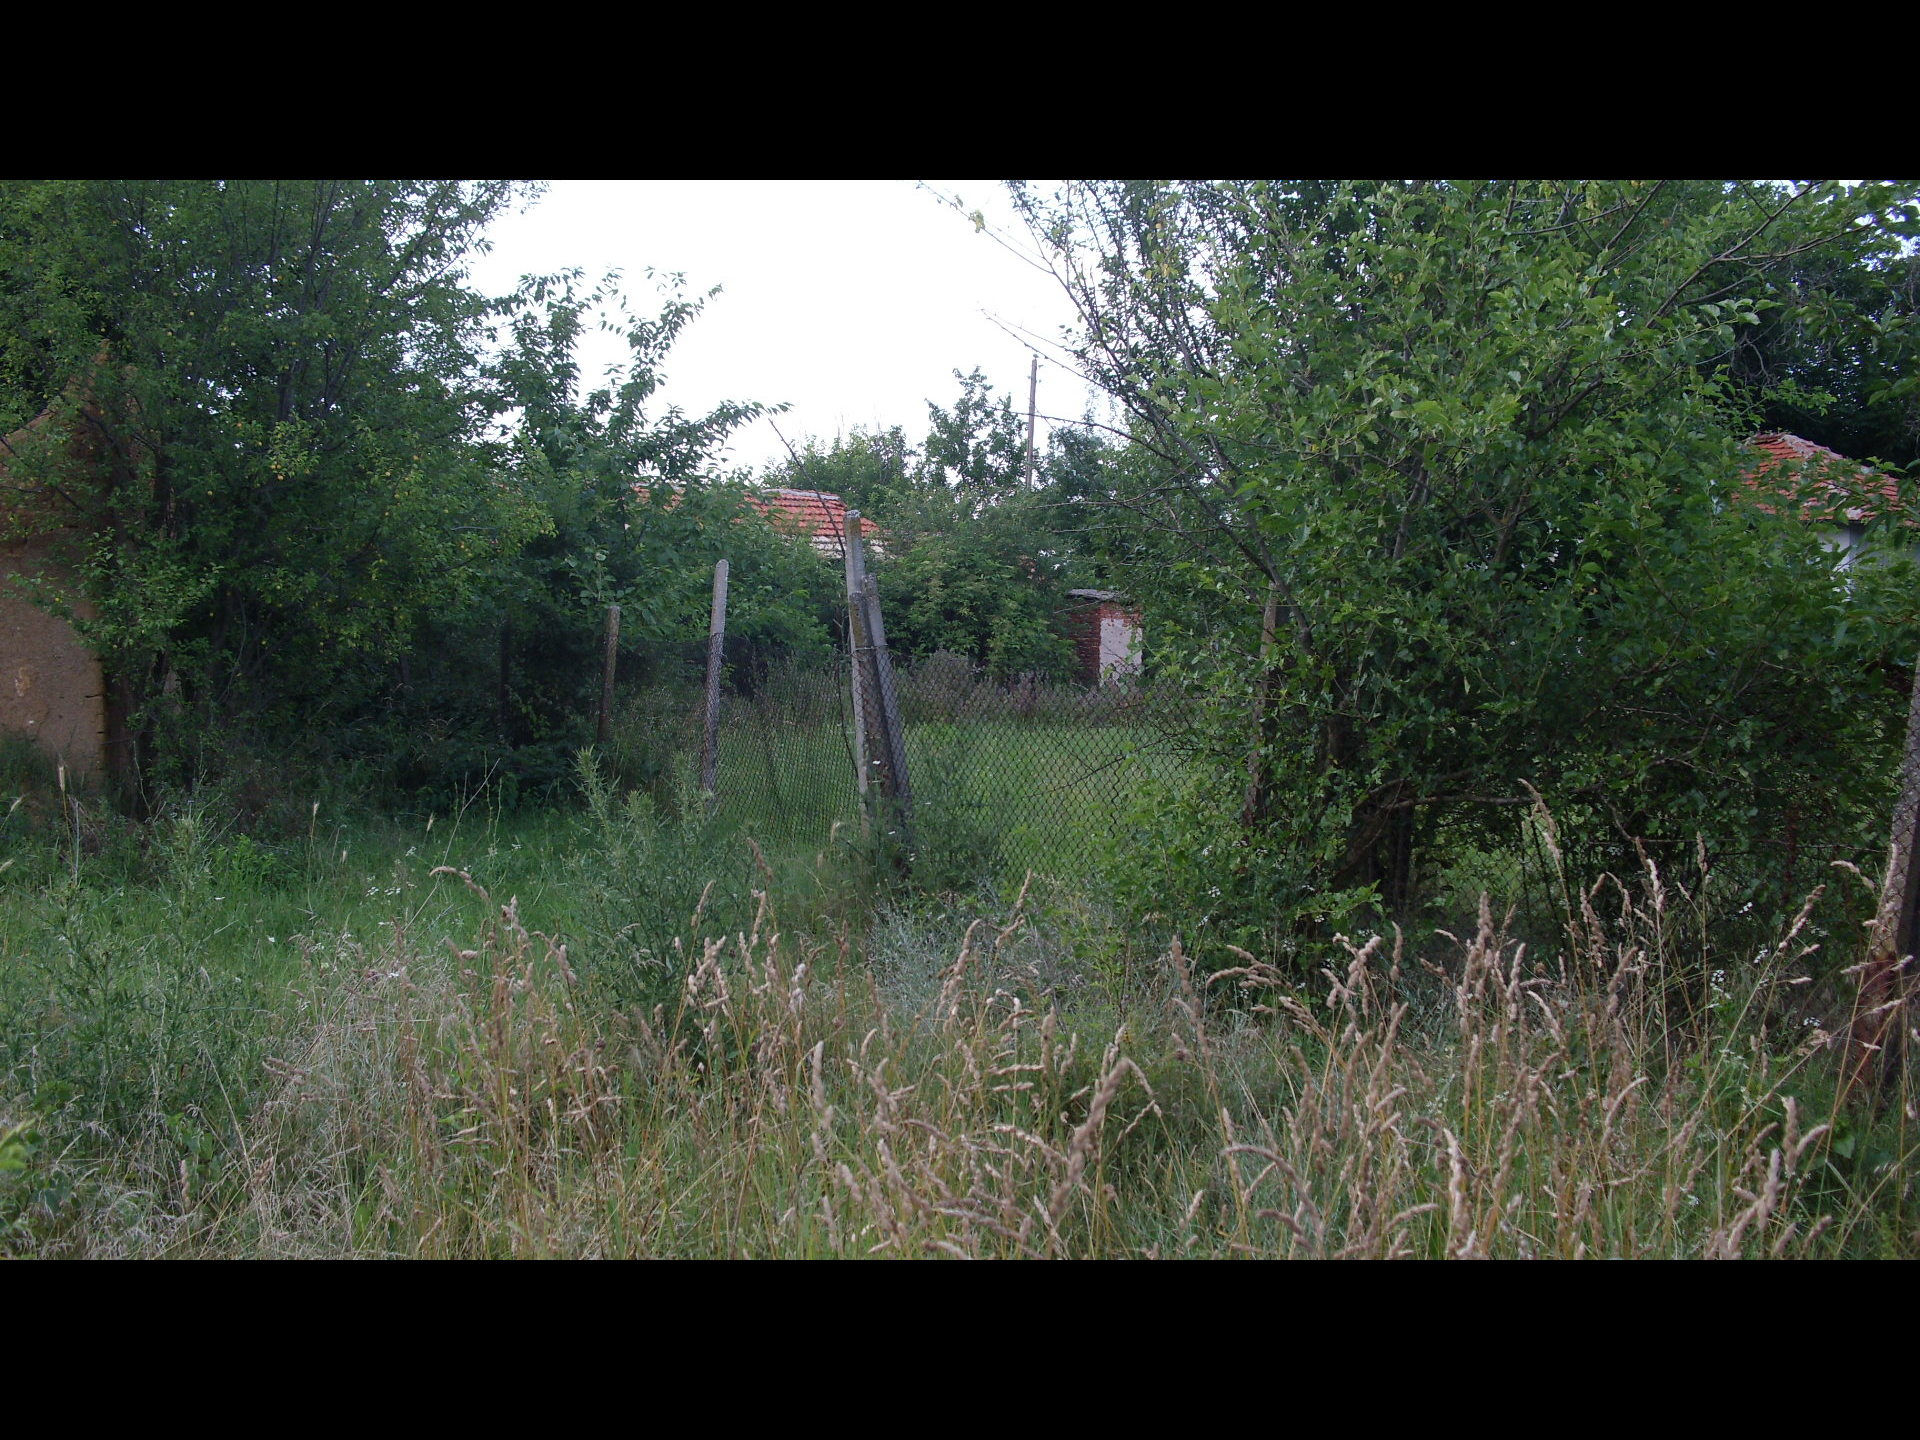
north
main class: Grassland
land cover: Grassland without tree/shrub cover
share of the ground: > 75 %
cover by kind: herbaceous plants 95 %, shrubs 5 %
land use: Agriculture (excluding fallow land and kitchen gardens)
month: June
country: BG
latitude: 43.6306
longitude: 23.3424
